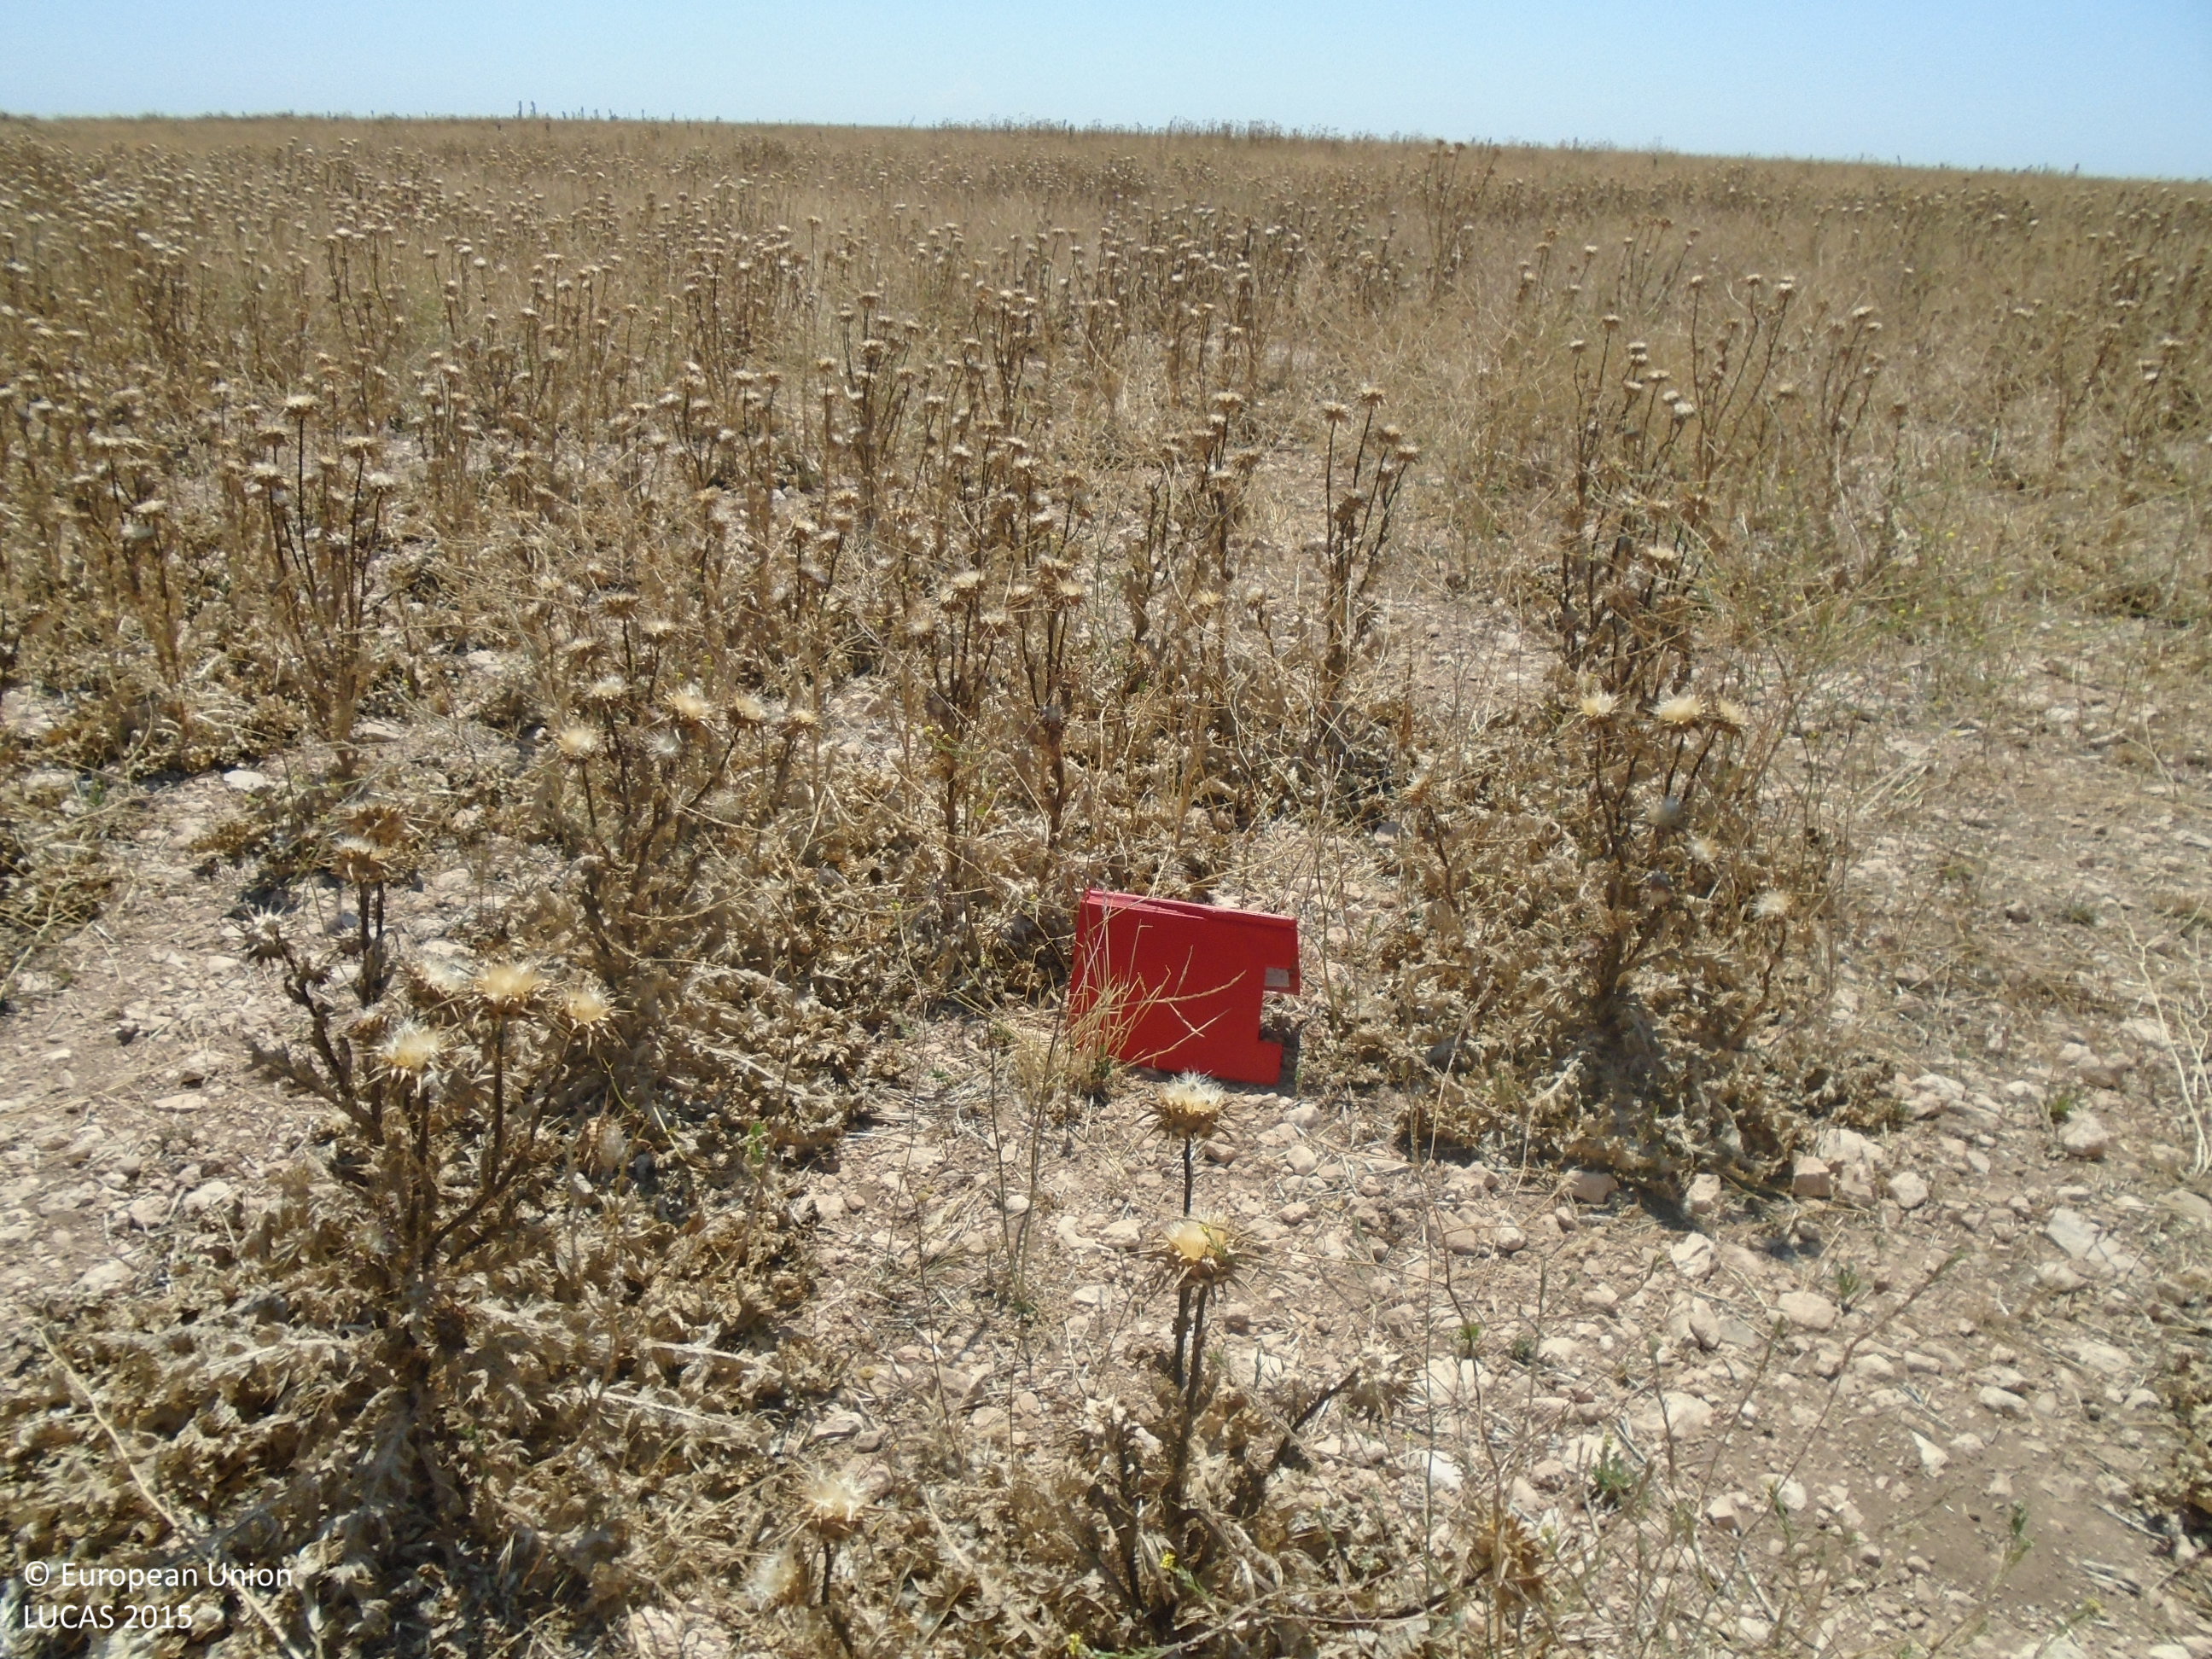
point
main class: Grassland
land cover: Spontaneously vegetated surfaces
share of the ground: > 75 %
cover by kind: herbaceous plants 90 %, consolidated bare surface 5 %, unconsolidated bare surface 5 %
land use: Fallow land
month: June
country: ES
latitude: 39.1420
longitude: -3.6604
